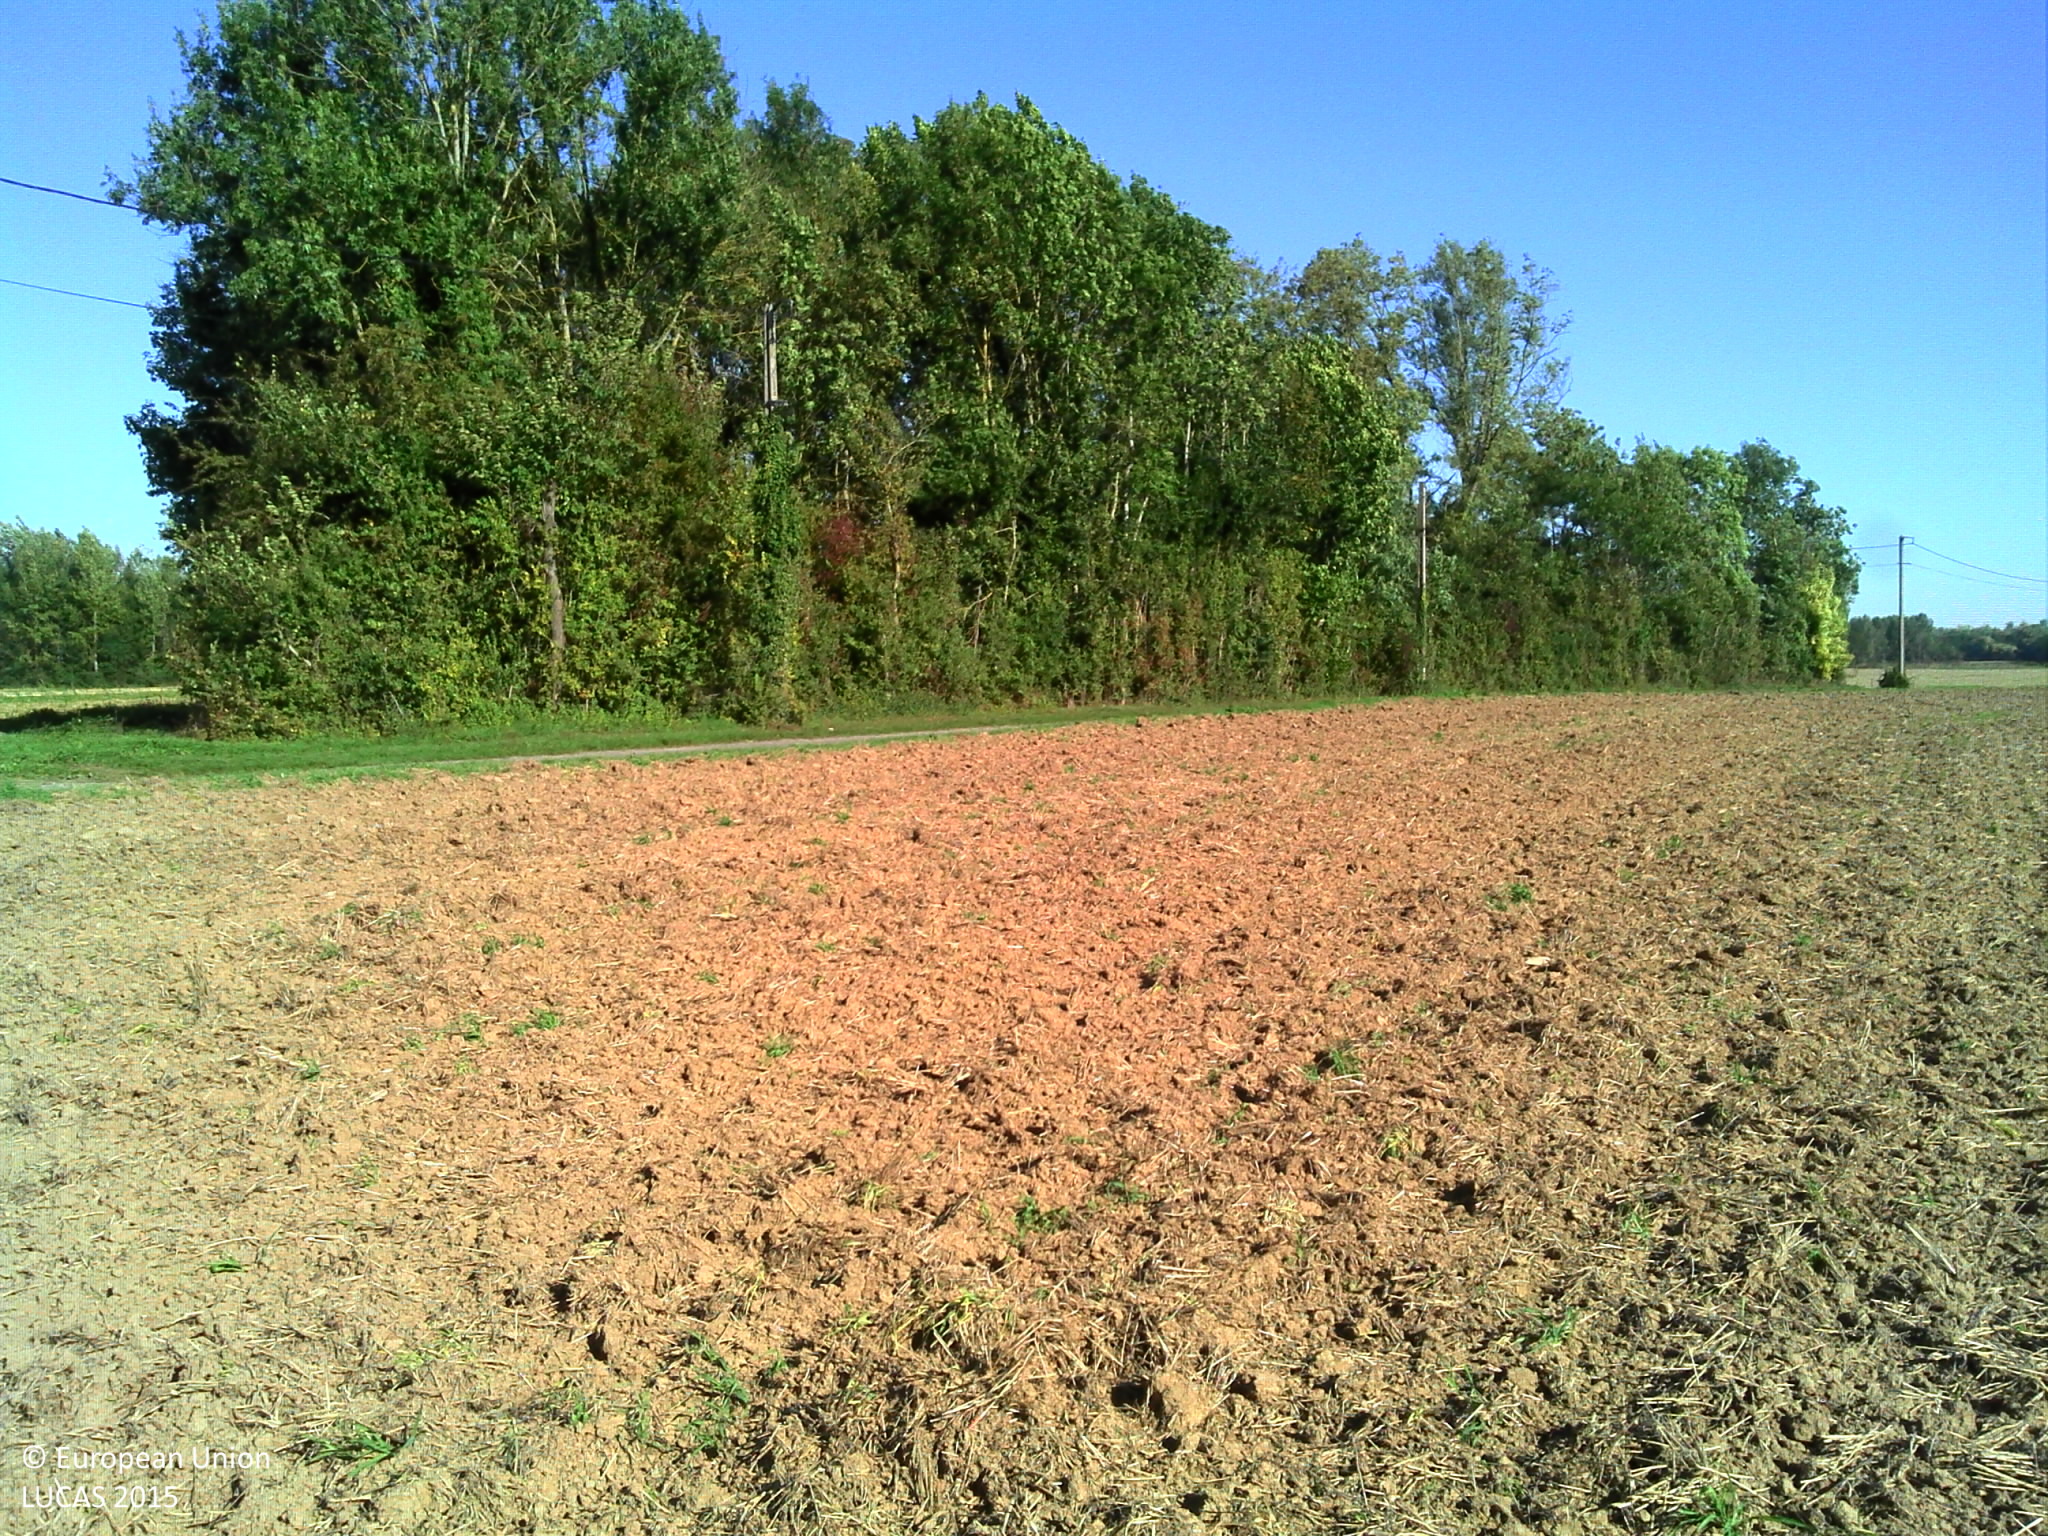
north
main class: Cropland
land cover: Common wheat
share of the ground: < 10 %
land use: Agriculture (excluding fallow land and kitchen gardens)
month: September
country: FR
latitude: 48.4220
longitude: 3.3858
